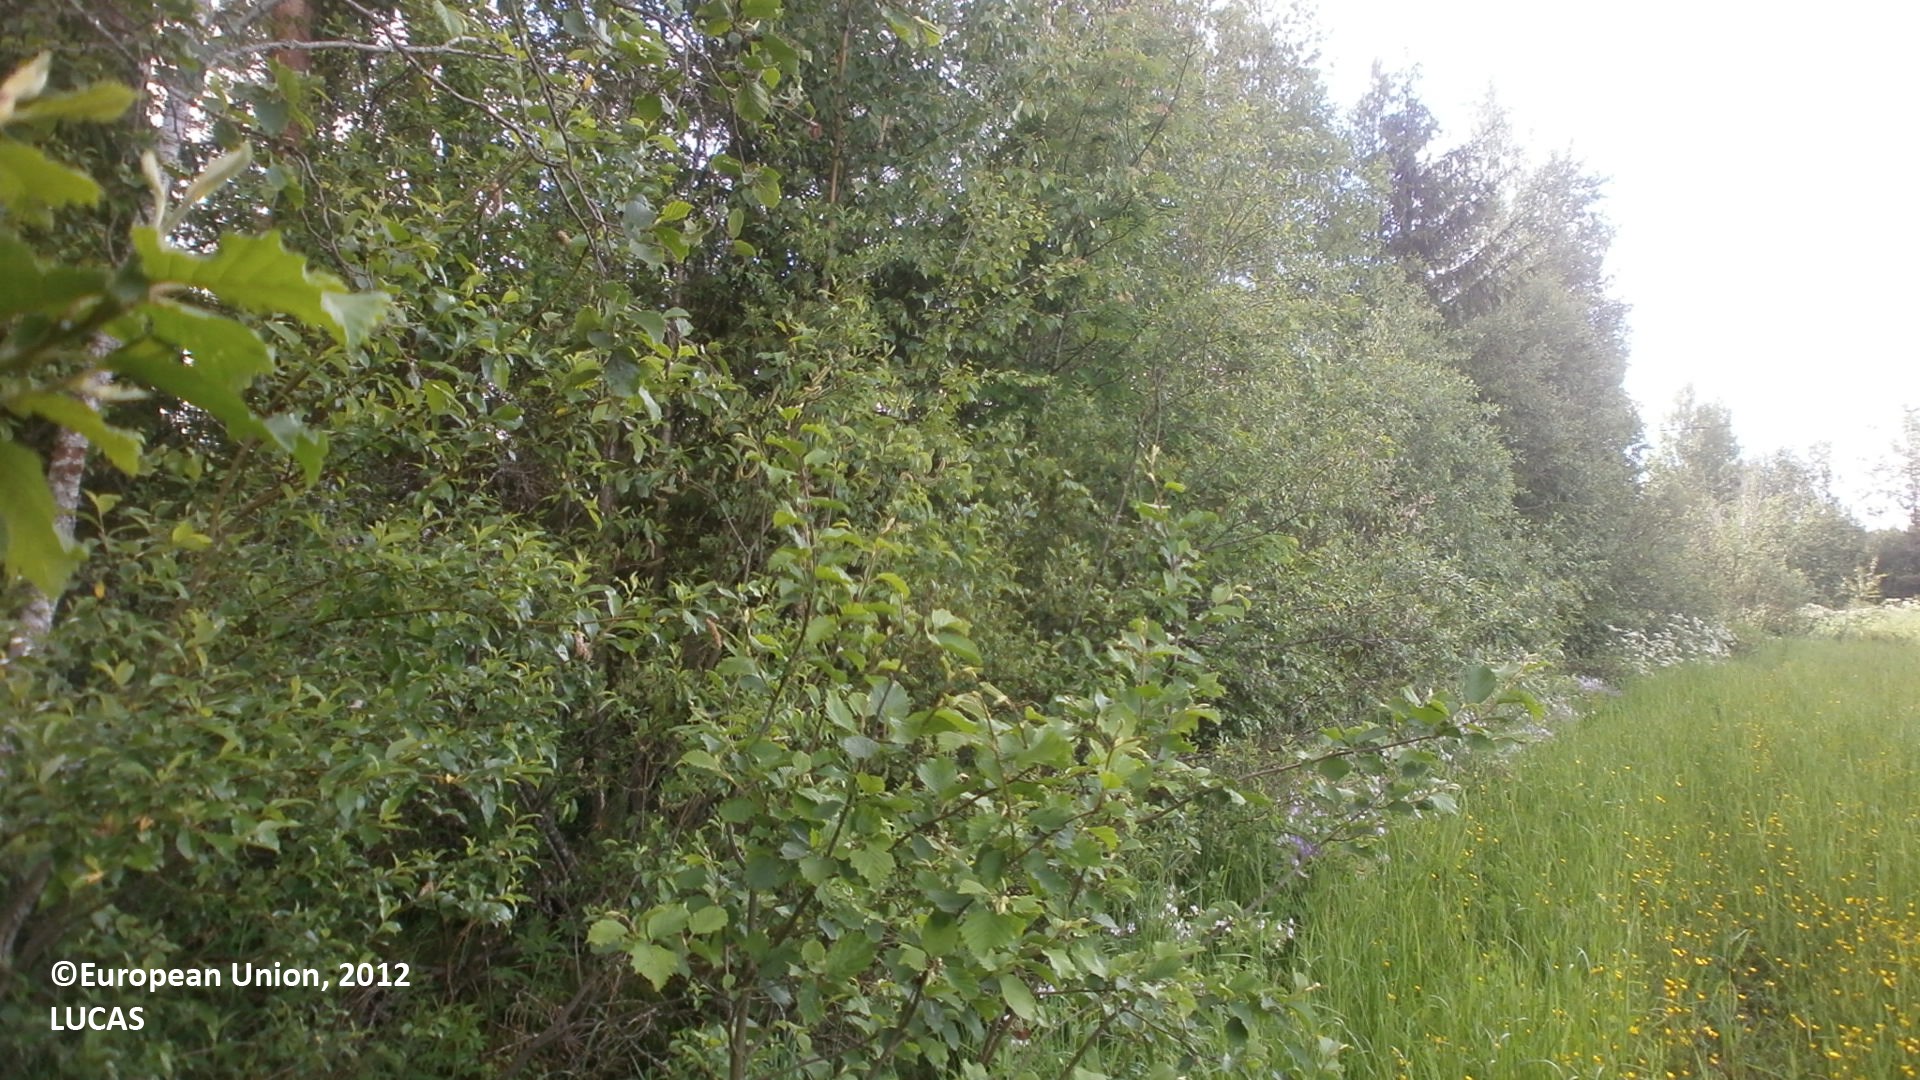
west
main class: Grassland
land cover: Grassland without tree/shrub cover
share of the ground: > 75 %
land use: Agriculture (excluding fallow land and kitchen gardens)
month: June
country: FI
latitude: 64.2303
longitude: 25.0291
